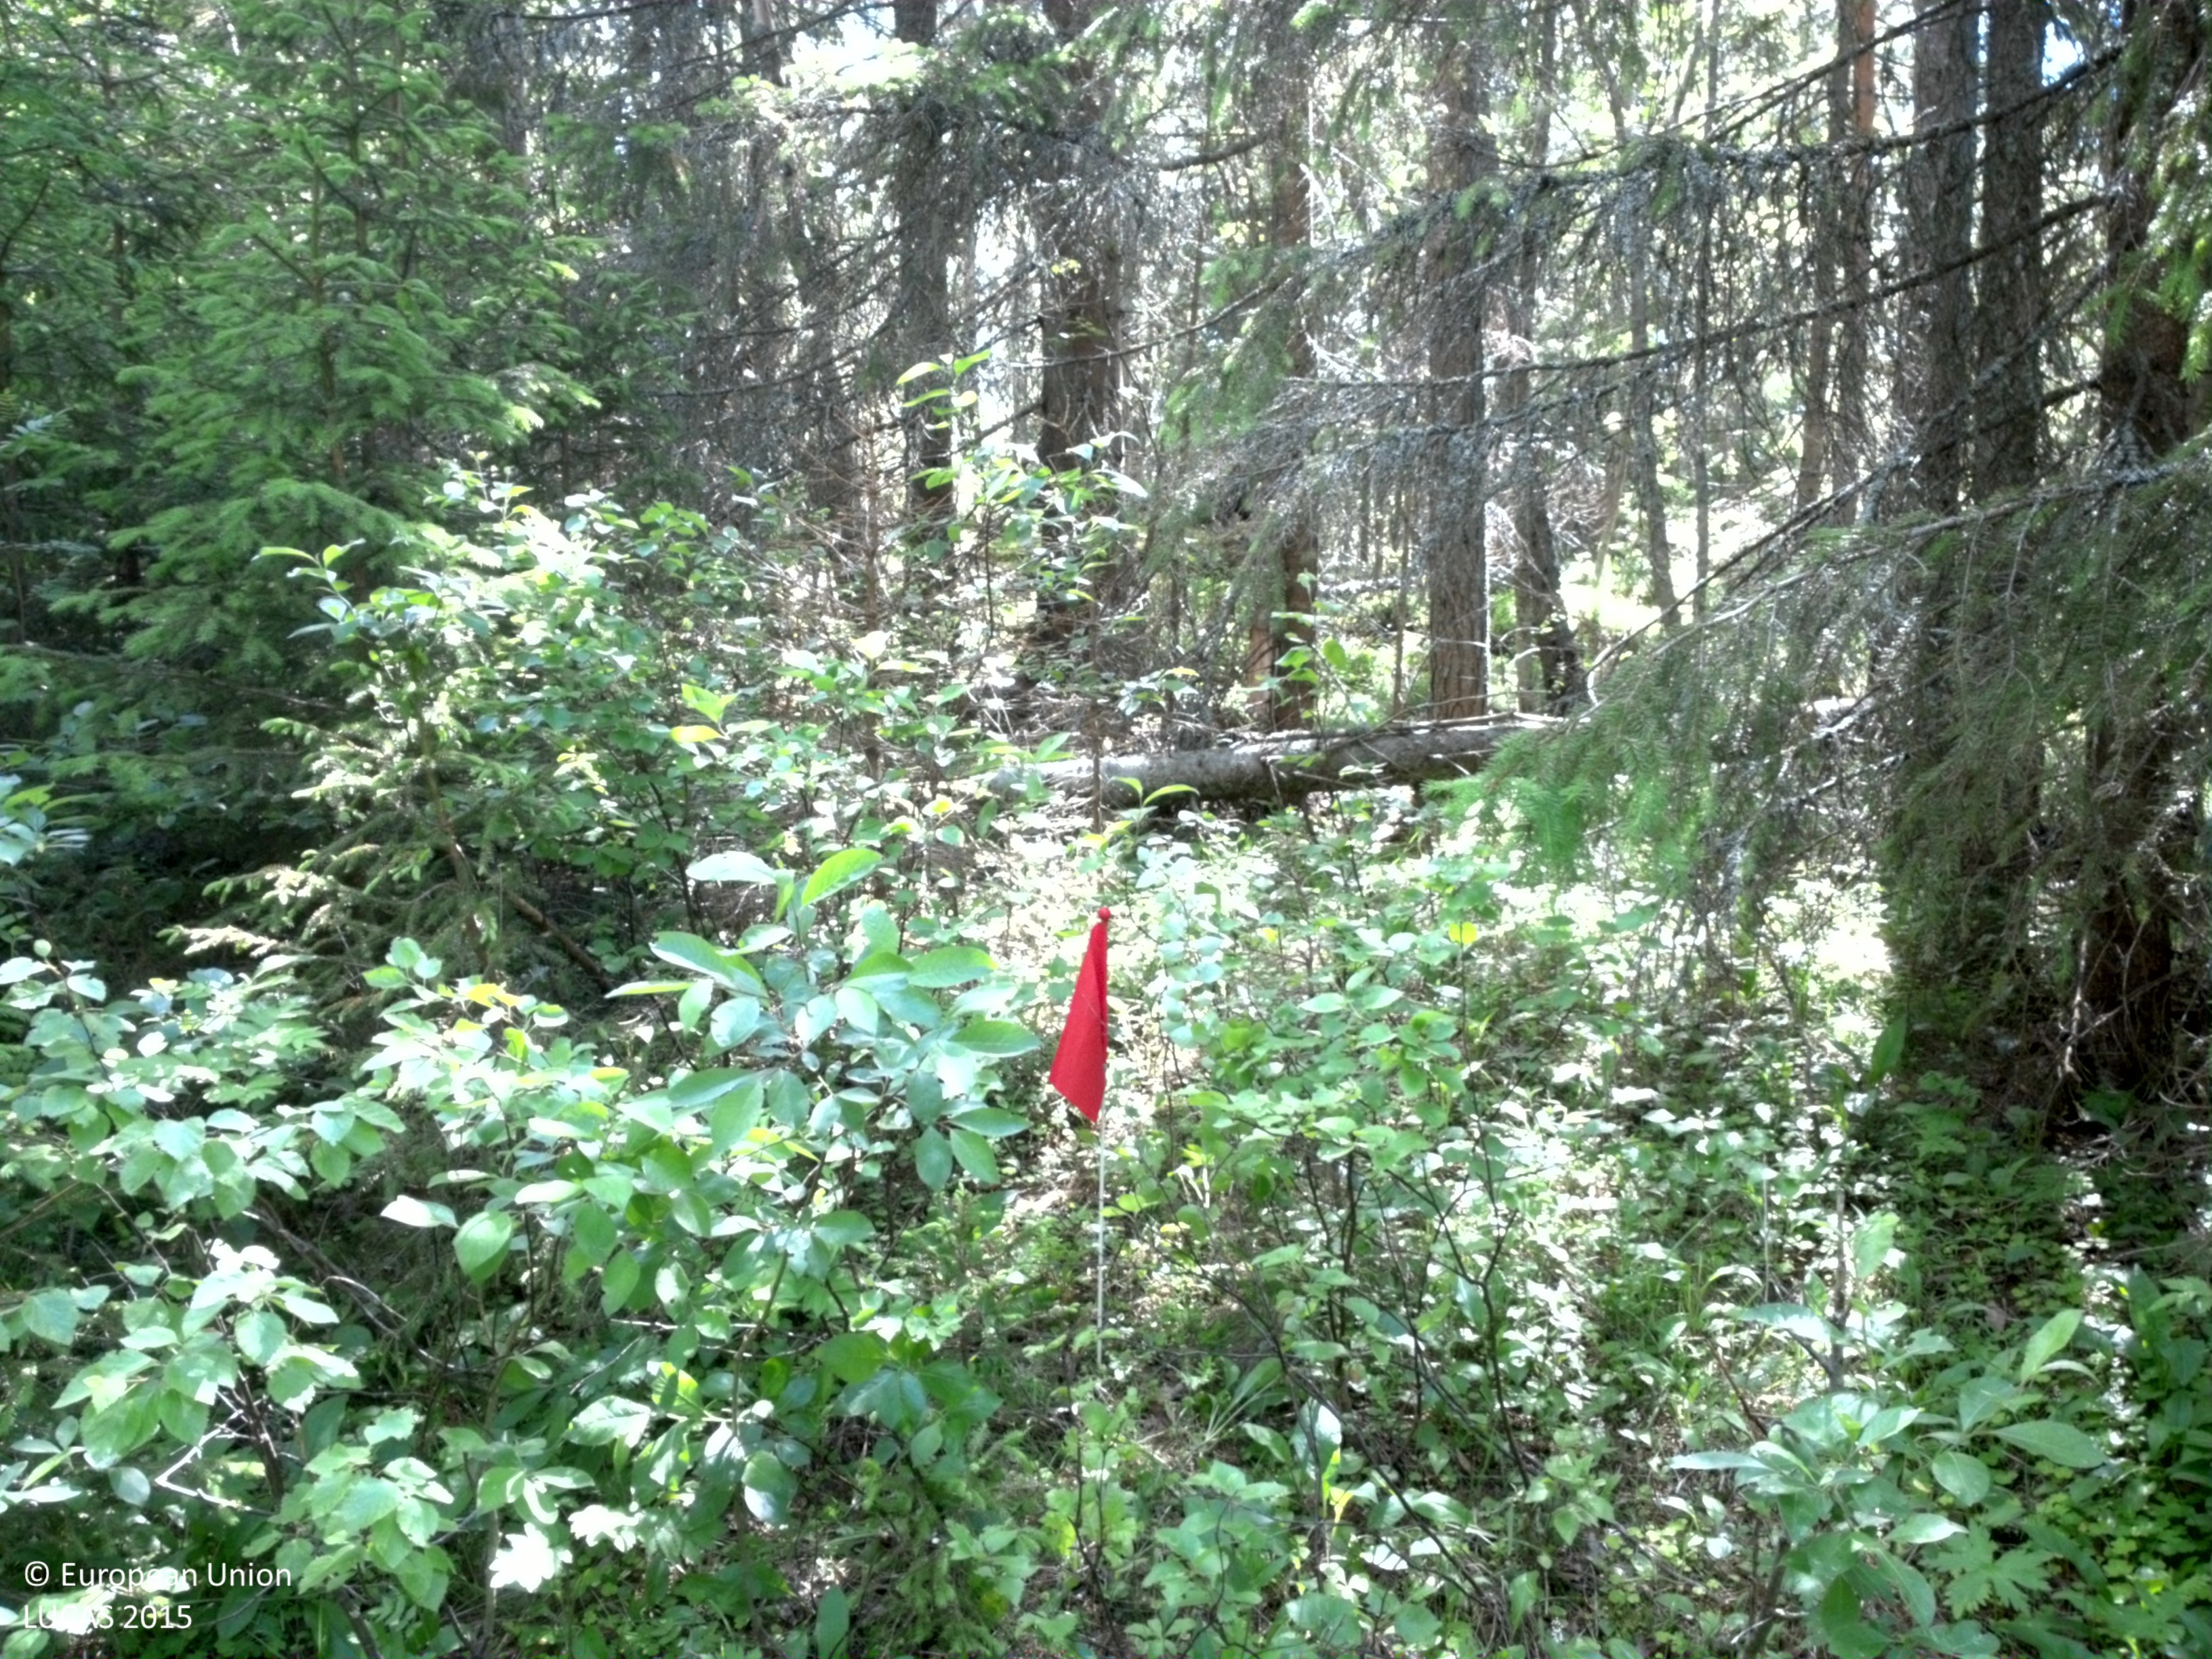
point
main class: Woodland
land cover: Spruce dominated mixed woodland
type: boreal forest
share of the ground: > 75 %
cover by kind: coniferous forest trees 60 %, broadleaved forest trees 20 %, shrubs 10 %, herbaceous plants 10 %
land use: Forestry
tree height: > 5 m
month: July
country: SE
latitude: 64.3800
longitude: 20.7377
